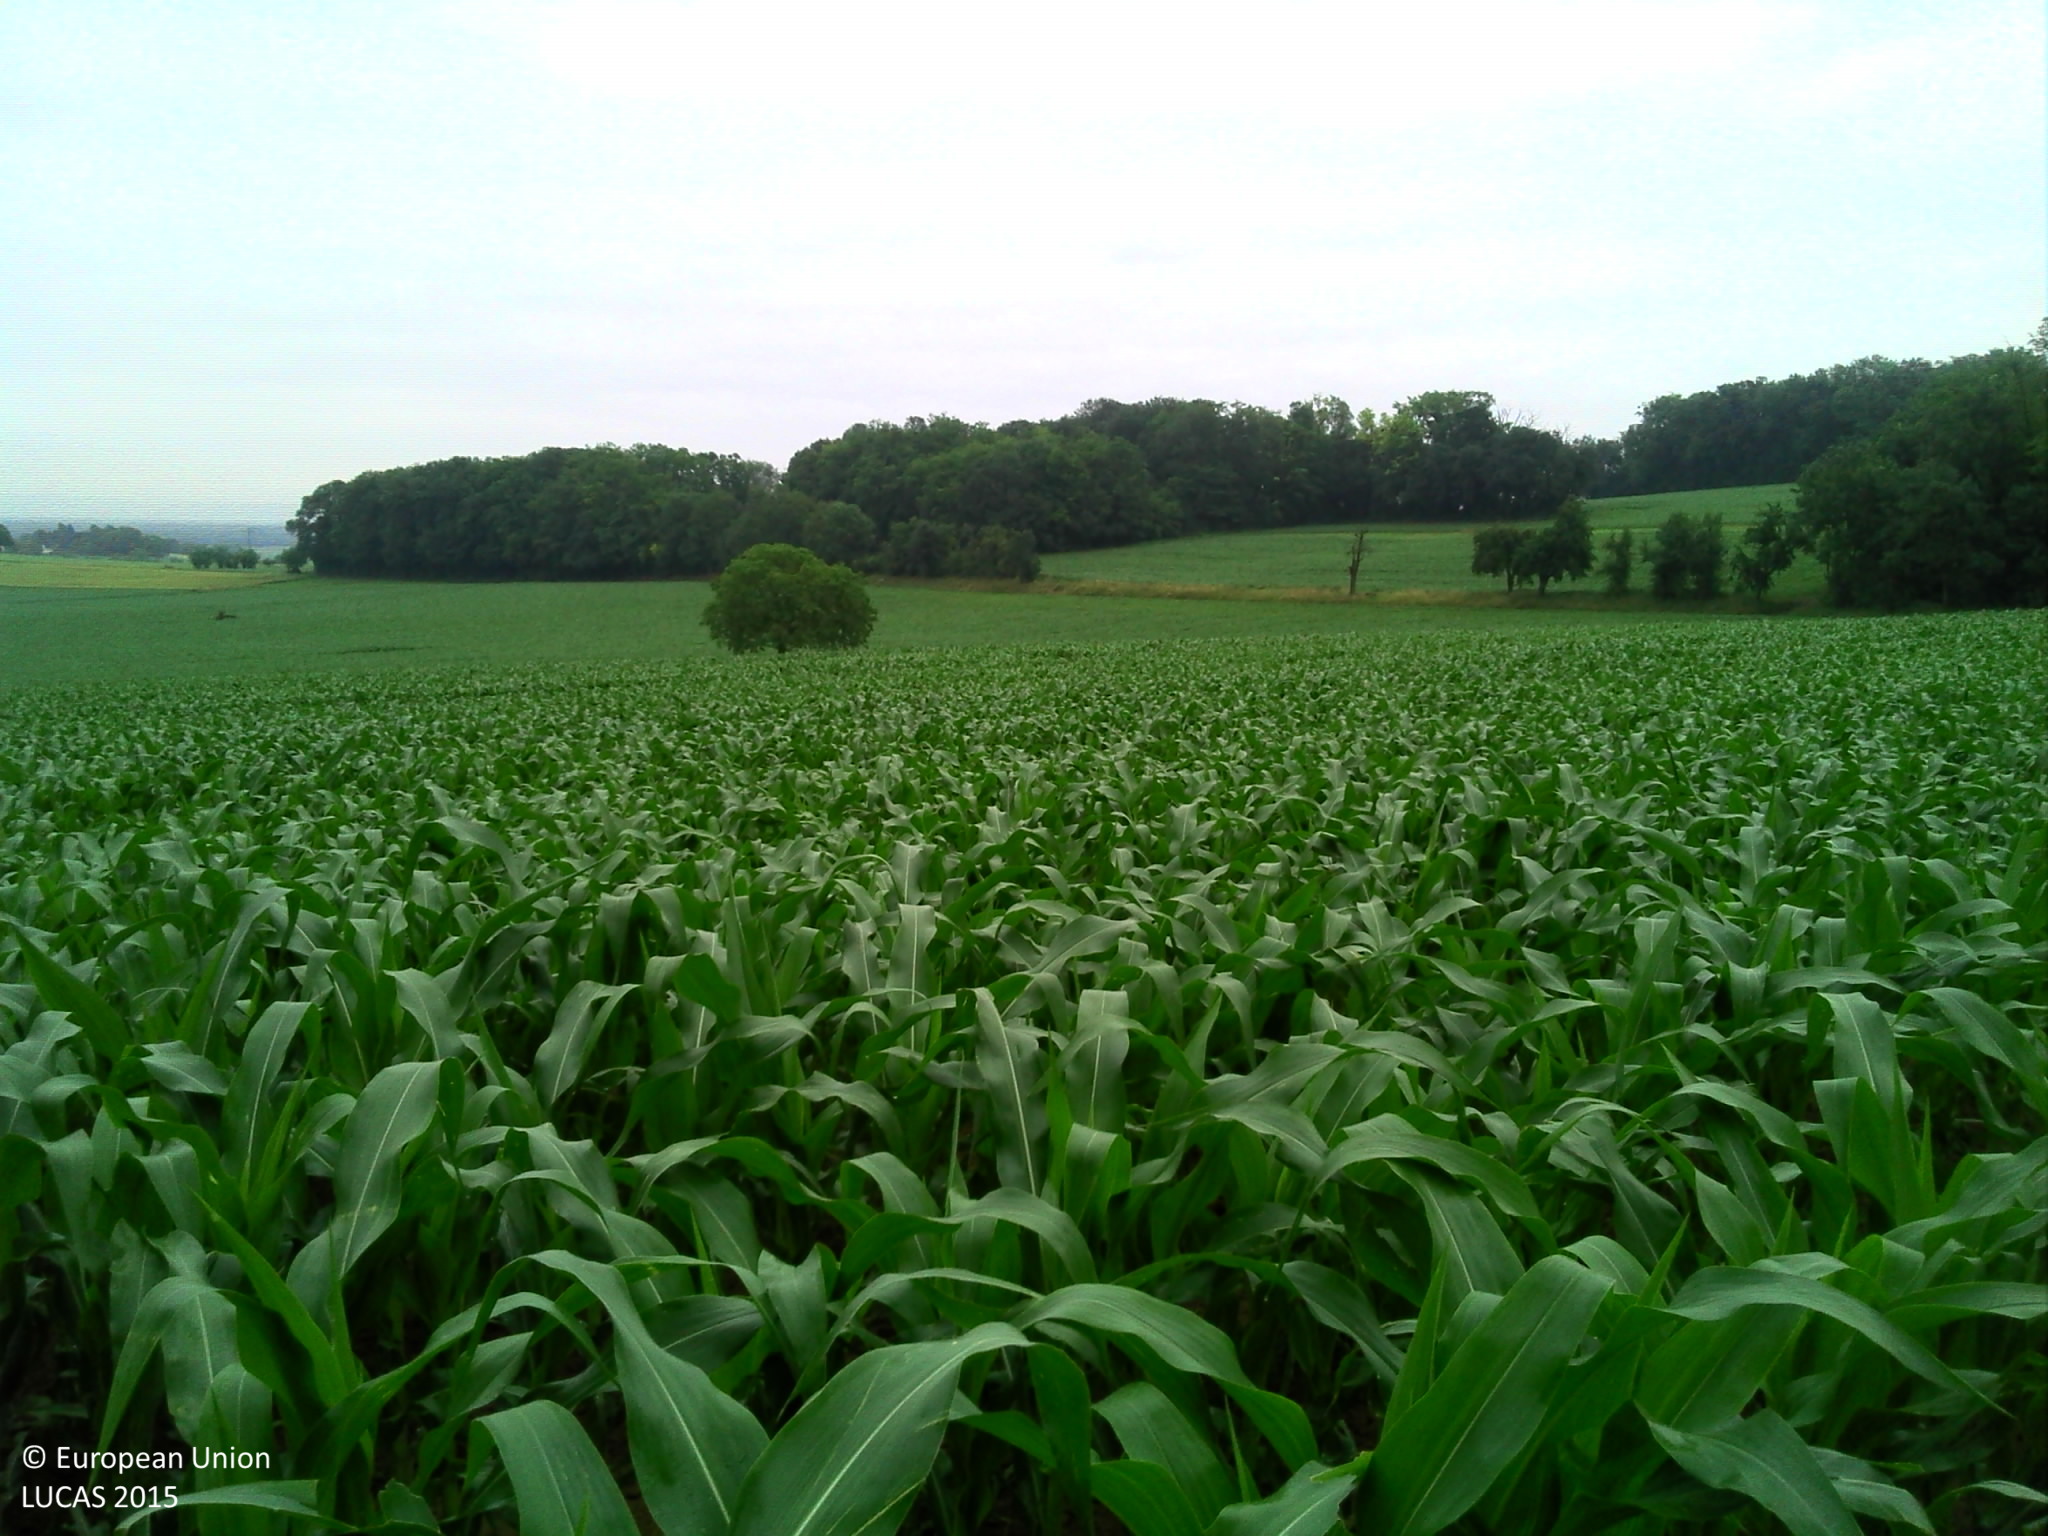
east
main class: Cropland
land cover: Maize
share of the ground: > 75 %
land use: Agriculture (excluding fallow land and kitchen gardens)
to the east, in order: Maize
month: June
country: FR
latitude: 47.7062
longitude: 7.3760
